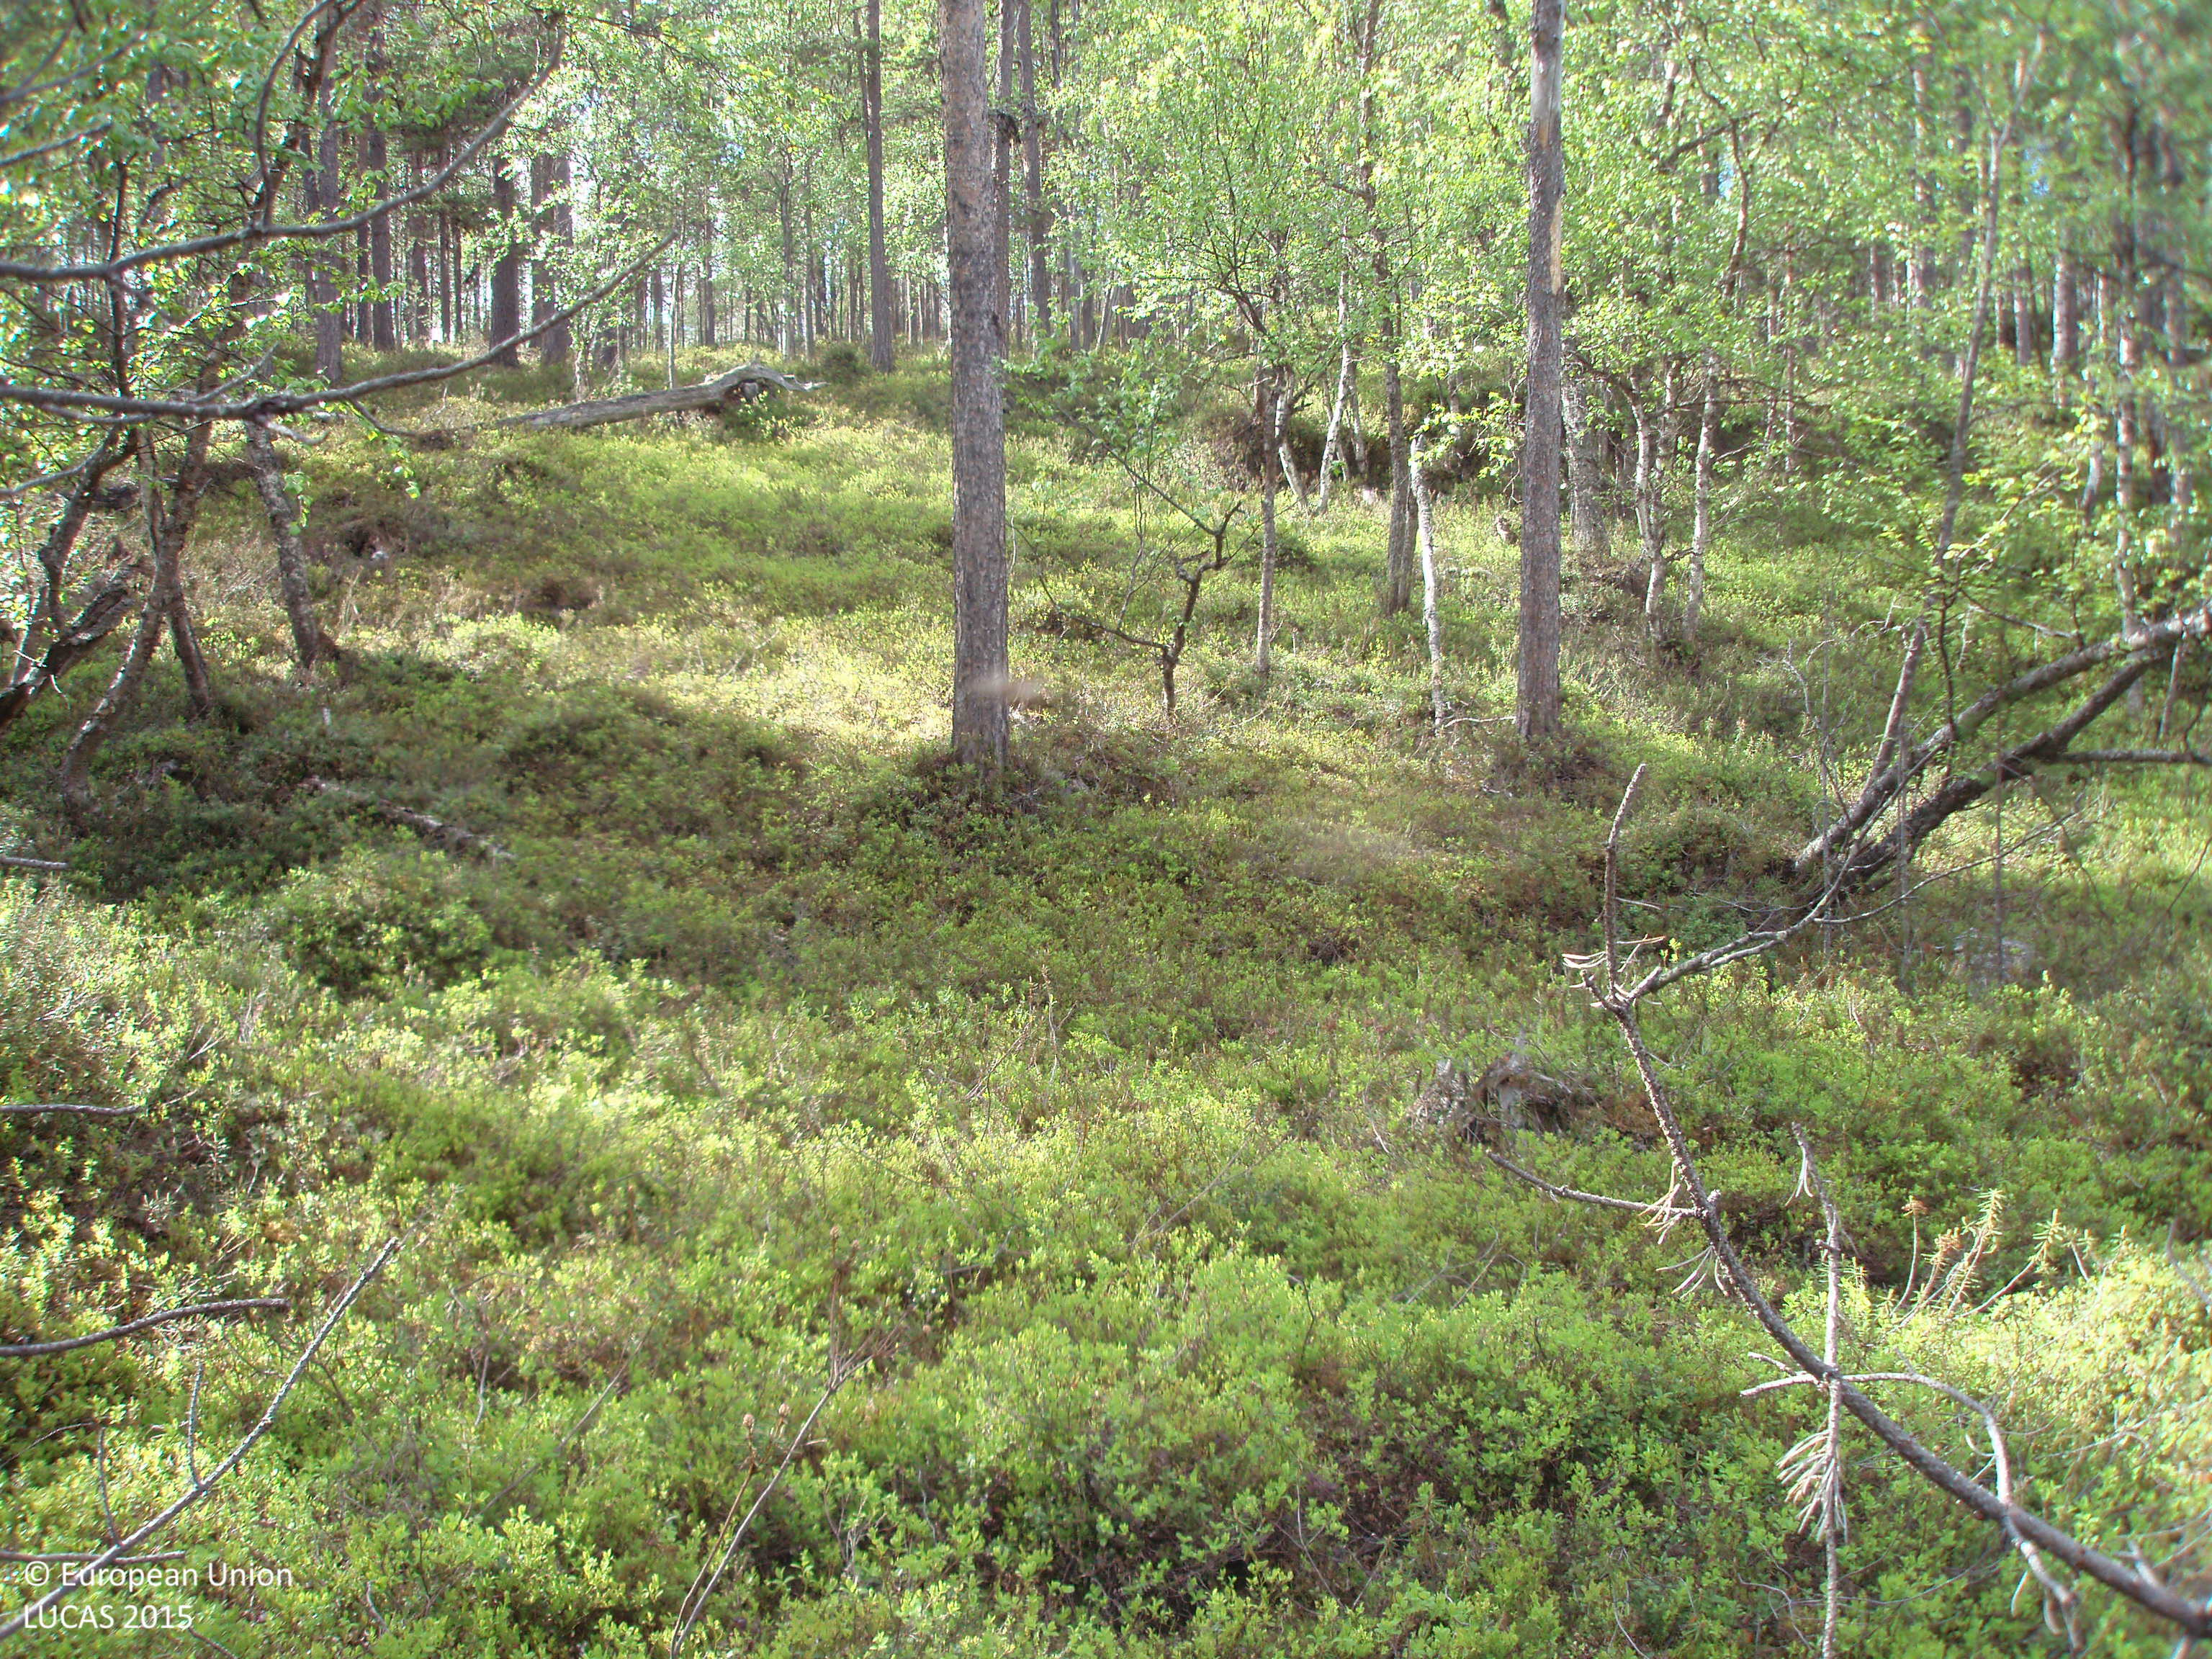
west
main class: Woodland
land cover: Pine dominated mixed woodland
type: boreal forest
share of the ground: > 75 %
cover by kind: broadleaved forest trees 45 %, coniferous forest trees 30 %, shrubs 15 %, herbaceous plants 5 %, unconsolidated bare surface 5 %
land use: Forestry
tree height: > 5 m
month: June
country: FI
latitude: 68.7691
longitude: 28.2850
